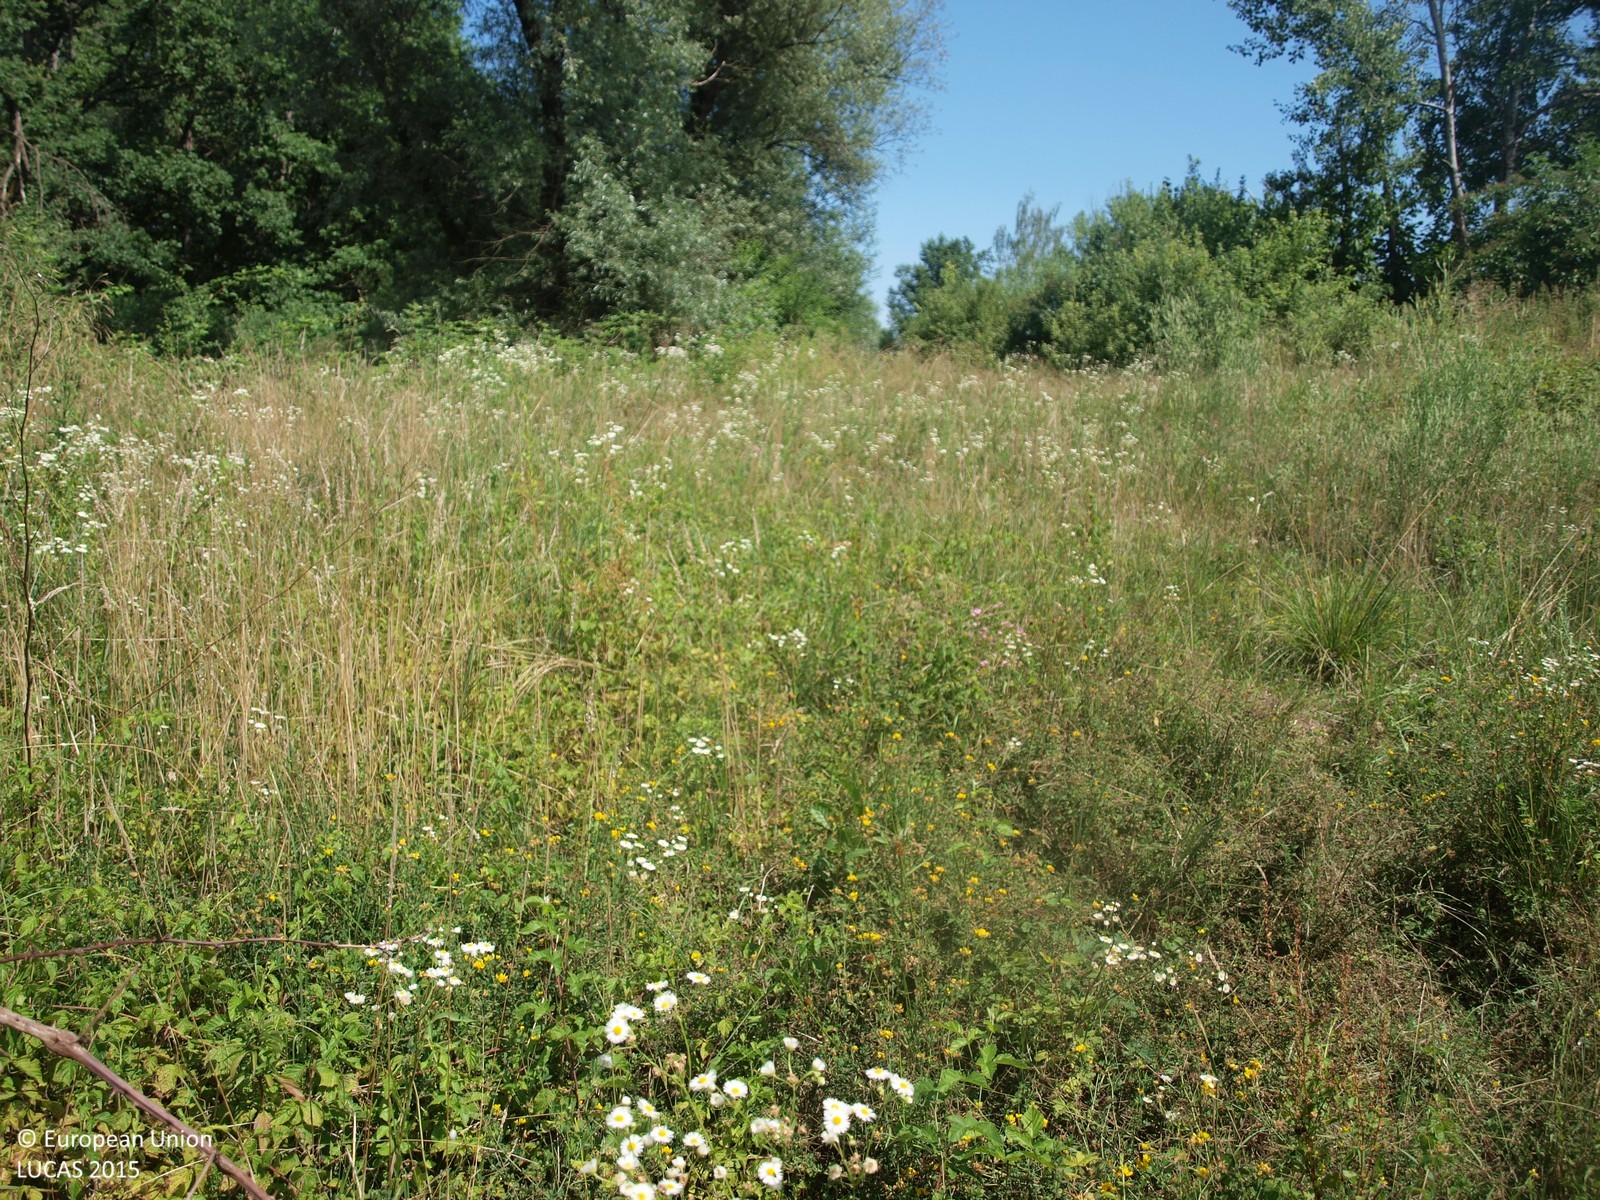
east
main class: Woodland
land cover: Broadleaved woodland
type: floodplain forest
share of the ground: > 75 %
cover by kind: broadleaved forest trees 100 %
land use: Forestry
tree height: > 5 m
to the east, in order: Broadleaved woodland
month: July
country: HR
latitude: 45.6377
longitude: 15.7315
